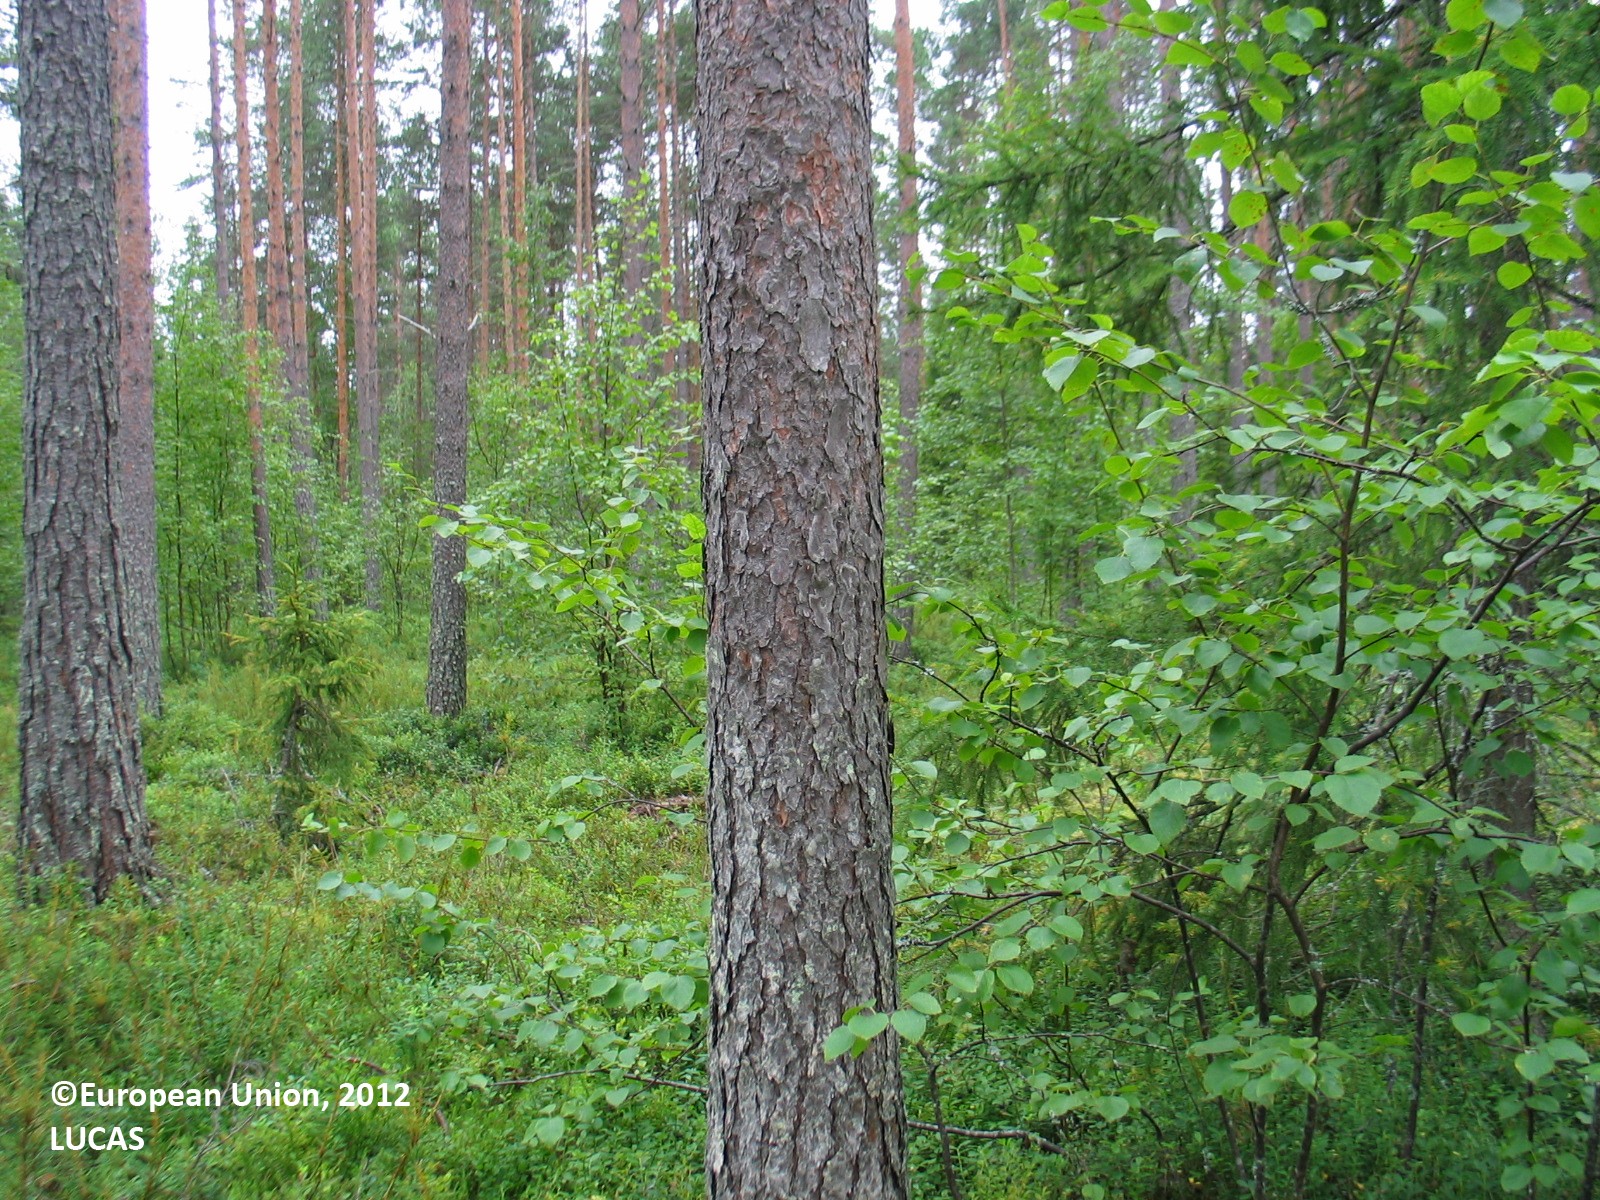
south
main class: Woodland
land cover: Pine dominated coniferous woodland
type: boreal forest
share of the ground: 25 - 50 %
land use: Forestry
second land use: Amenities, museums, leisure
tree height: > 5 m
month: August
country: FI
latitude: 65.0939
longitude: 25.4684
